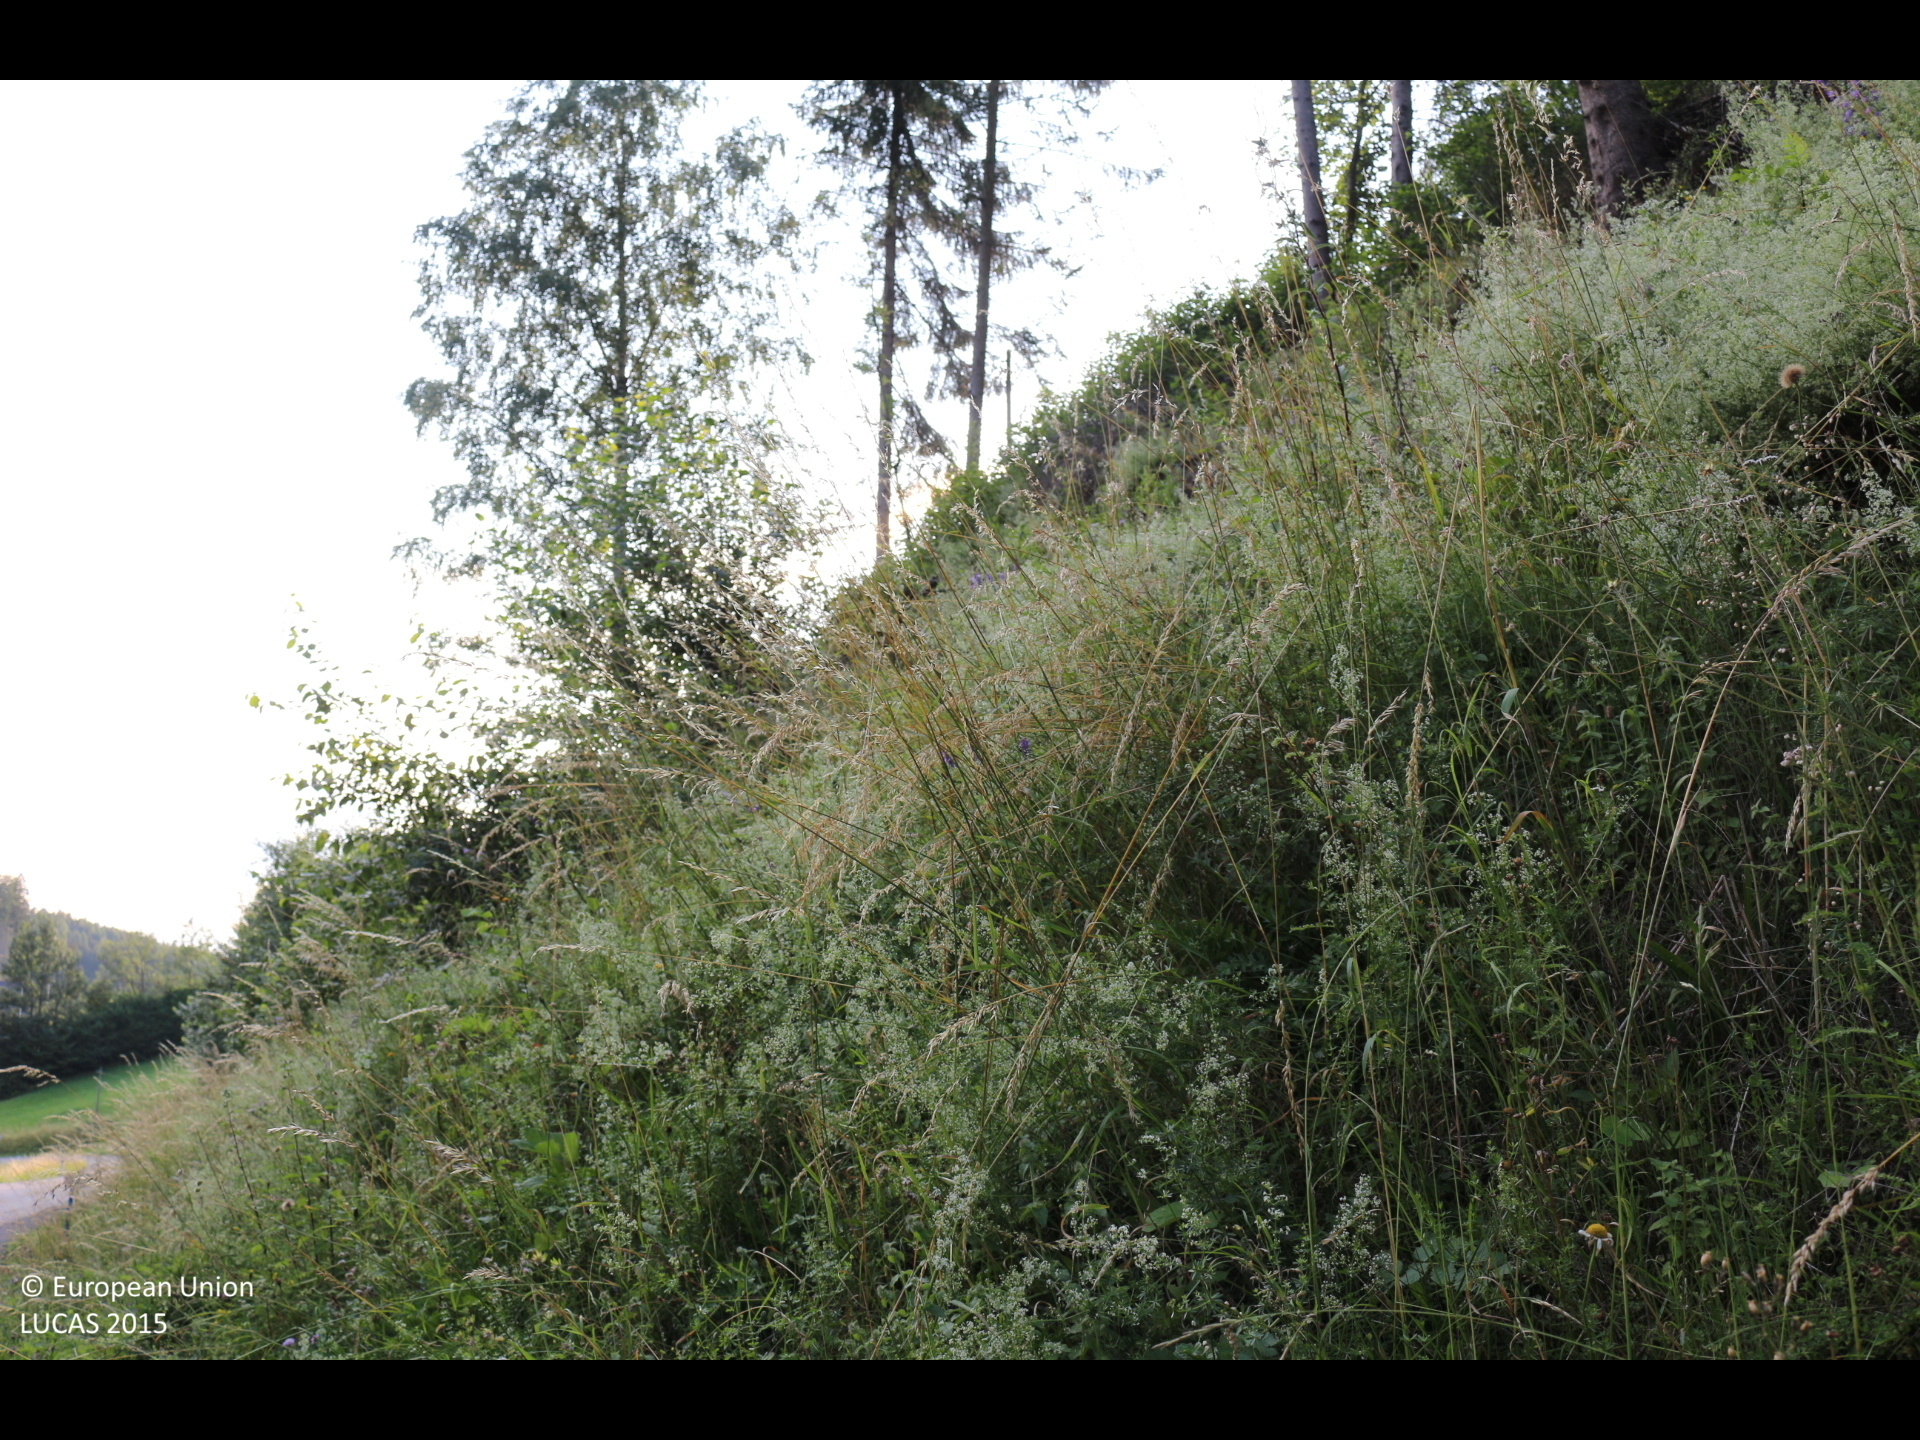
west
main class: Grassland
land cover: Grassland without tree/shrub cover
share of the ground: > 75 %
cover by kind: herbaceous plants 95 %, shrubs 5 %
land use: Road transport
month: July
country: AT
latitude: 46.9193
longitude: 14.6074
